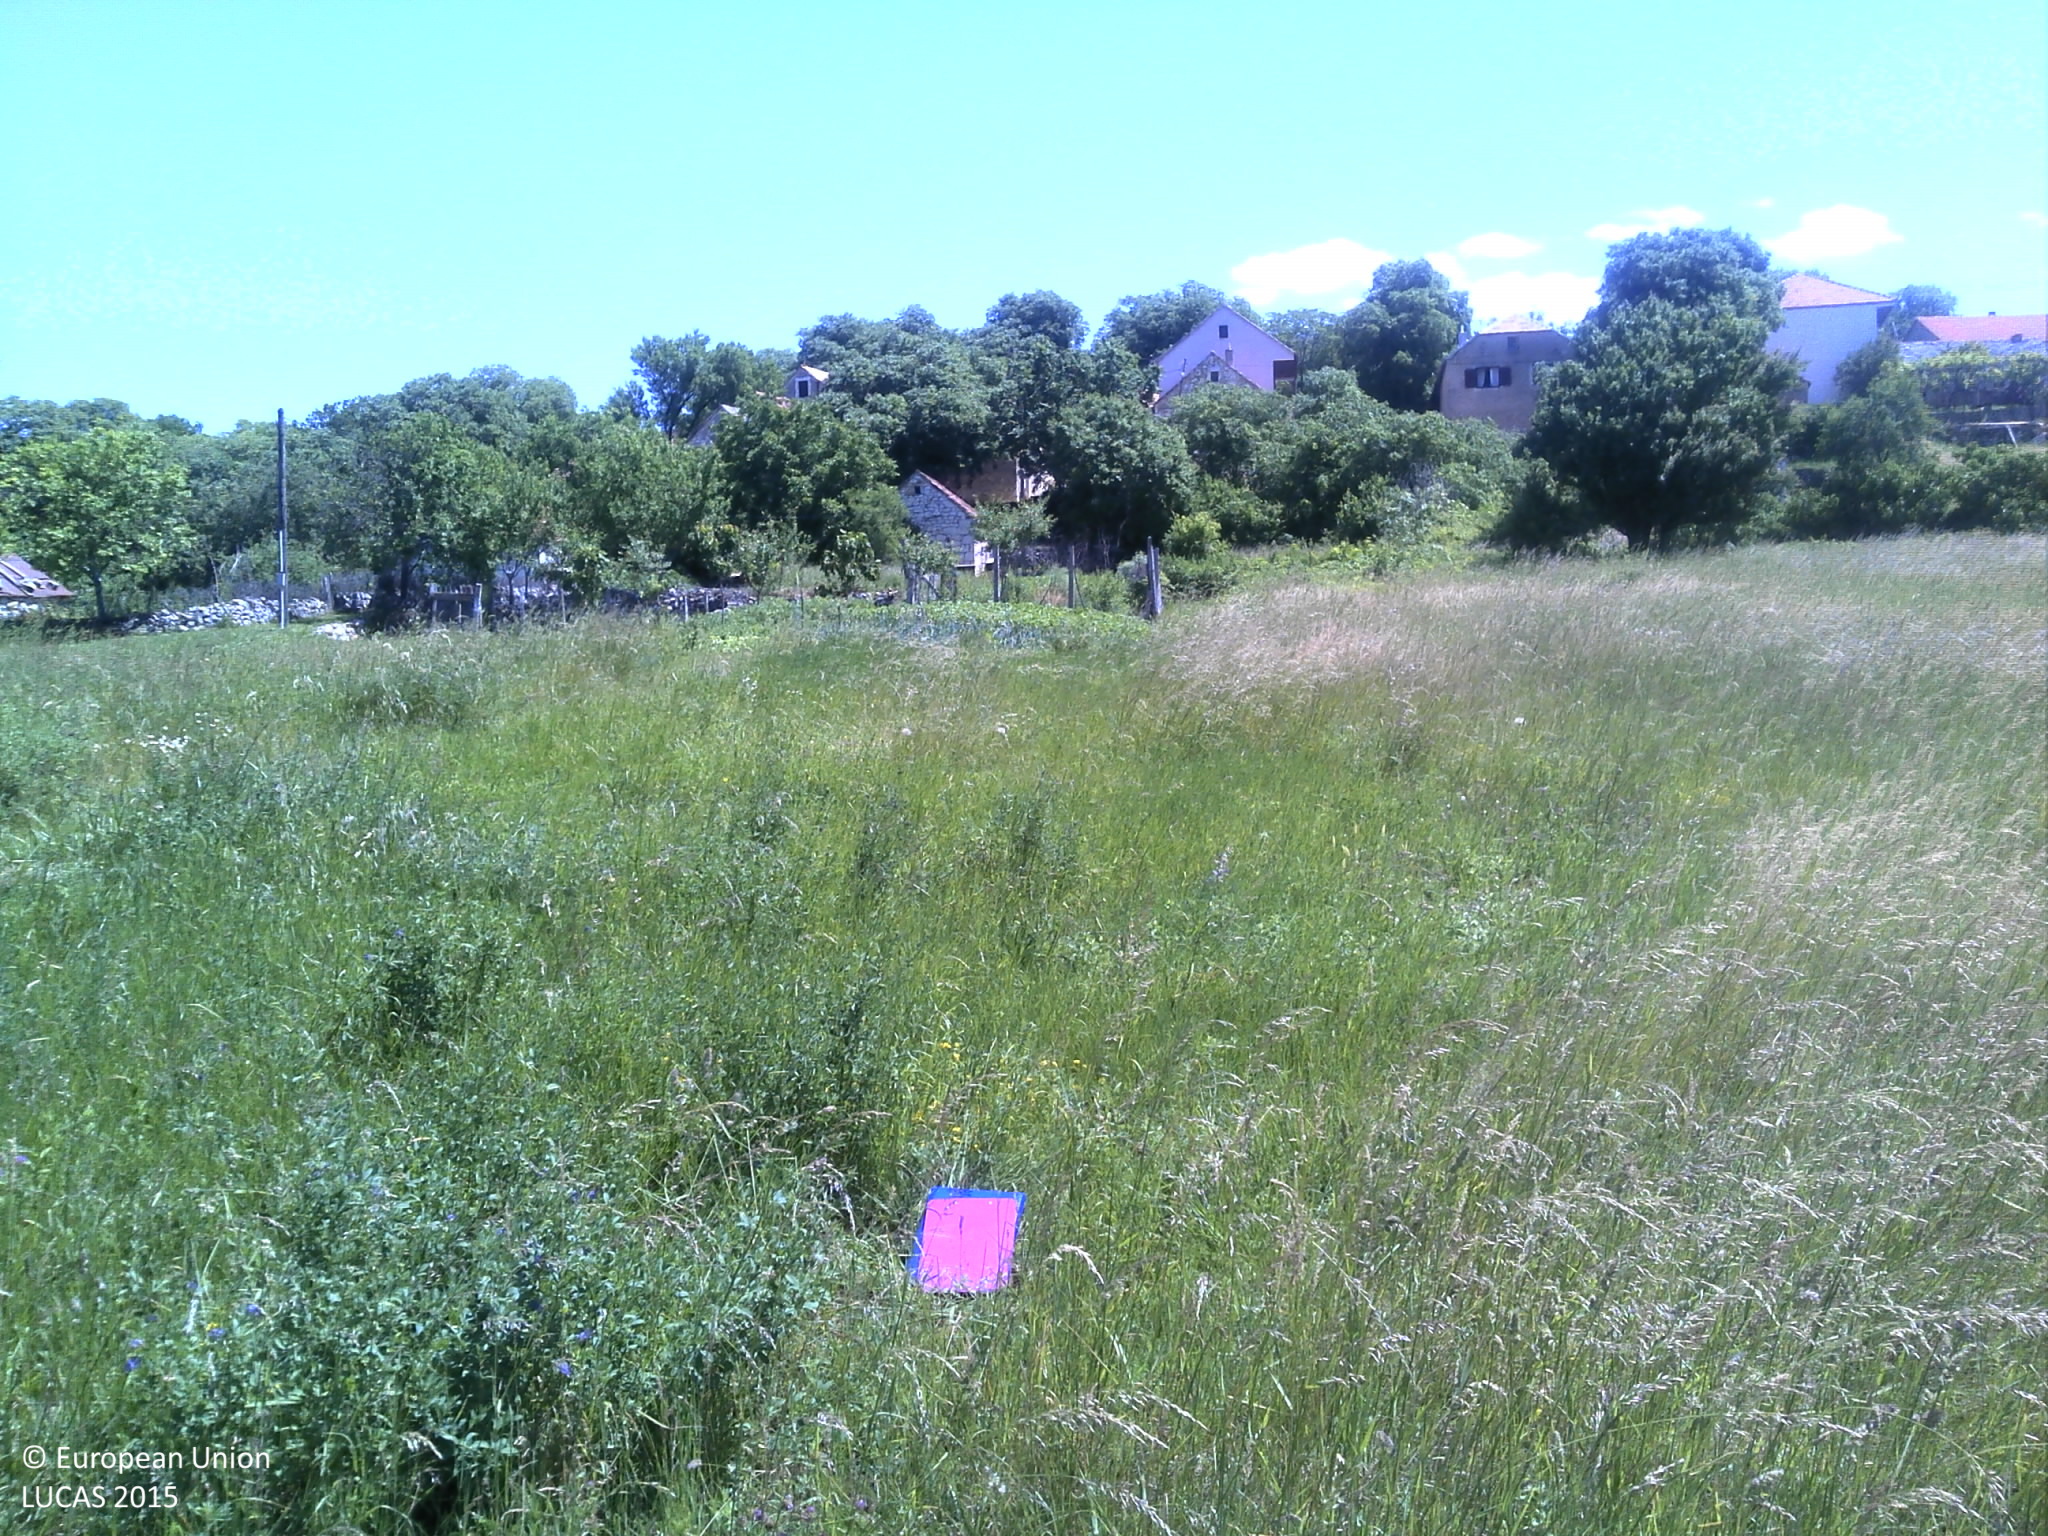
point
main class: Grassland
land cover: Grassland without tree/shrub cover
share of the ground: > 75 %
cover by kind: herbaceous plants 100 %
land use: Agriculture (excluding fallow land and kitchen gardens)
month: May
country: HR
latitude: 43.8921
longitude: 16.2286
